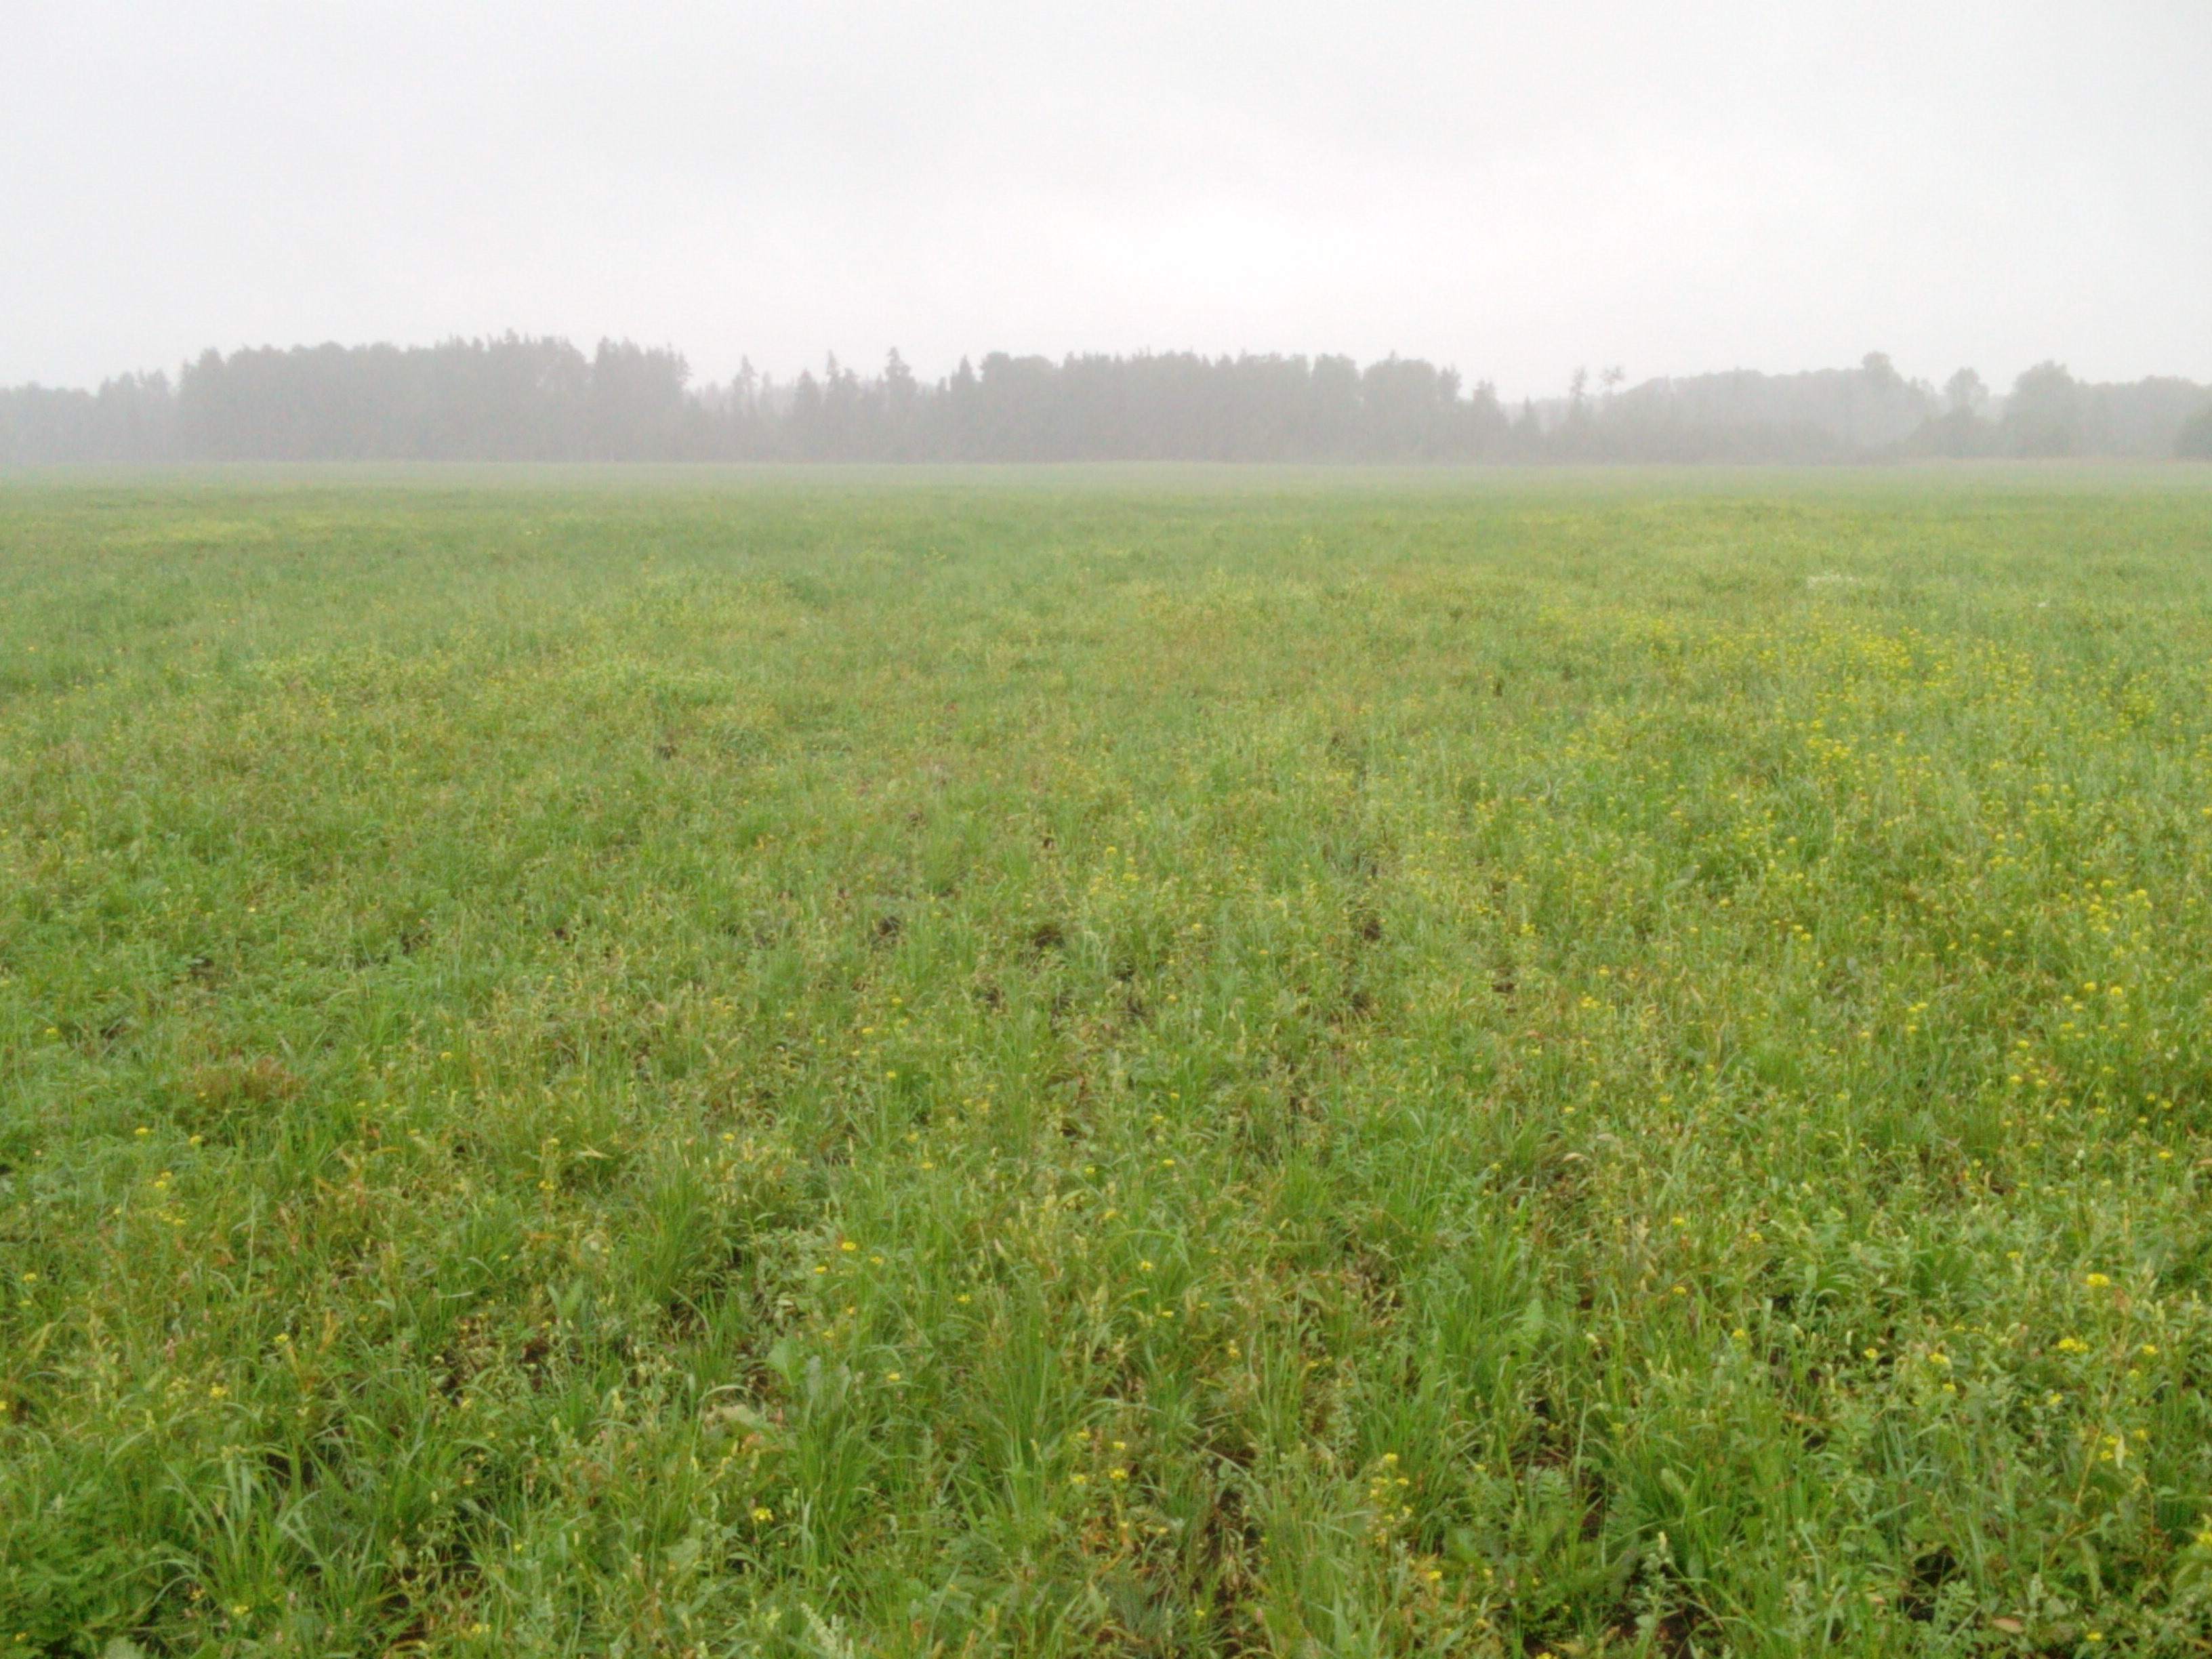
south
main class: Grassland
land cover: Spontaneously vegetated surfaces
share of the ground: > 75 %
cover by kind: herbaceous plants 100 %
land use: Fallow land
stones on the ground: < 10 %
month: September
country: LT
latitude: 55.9588
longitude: 22.4726
